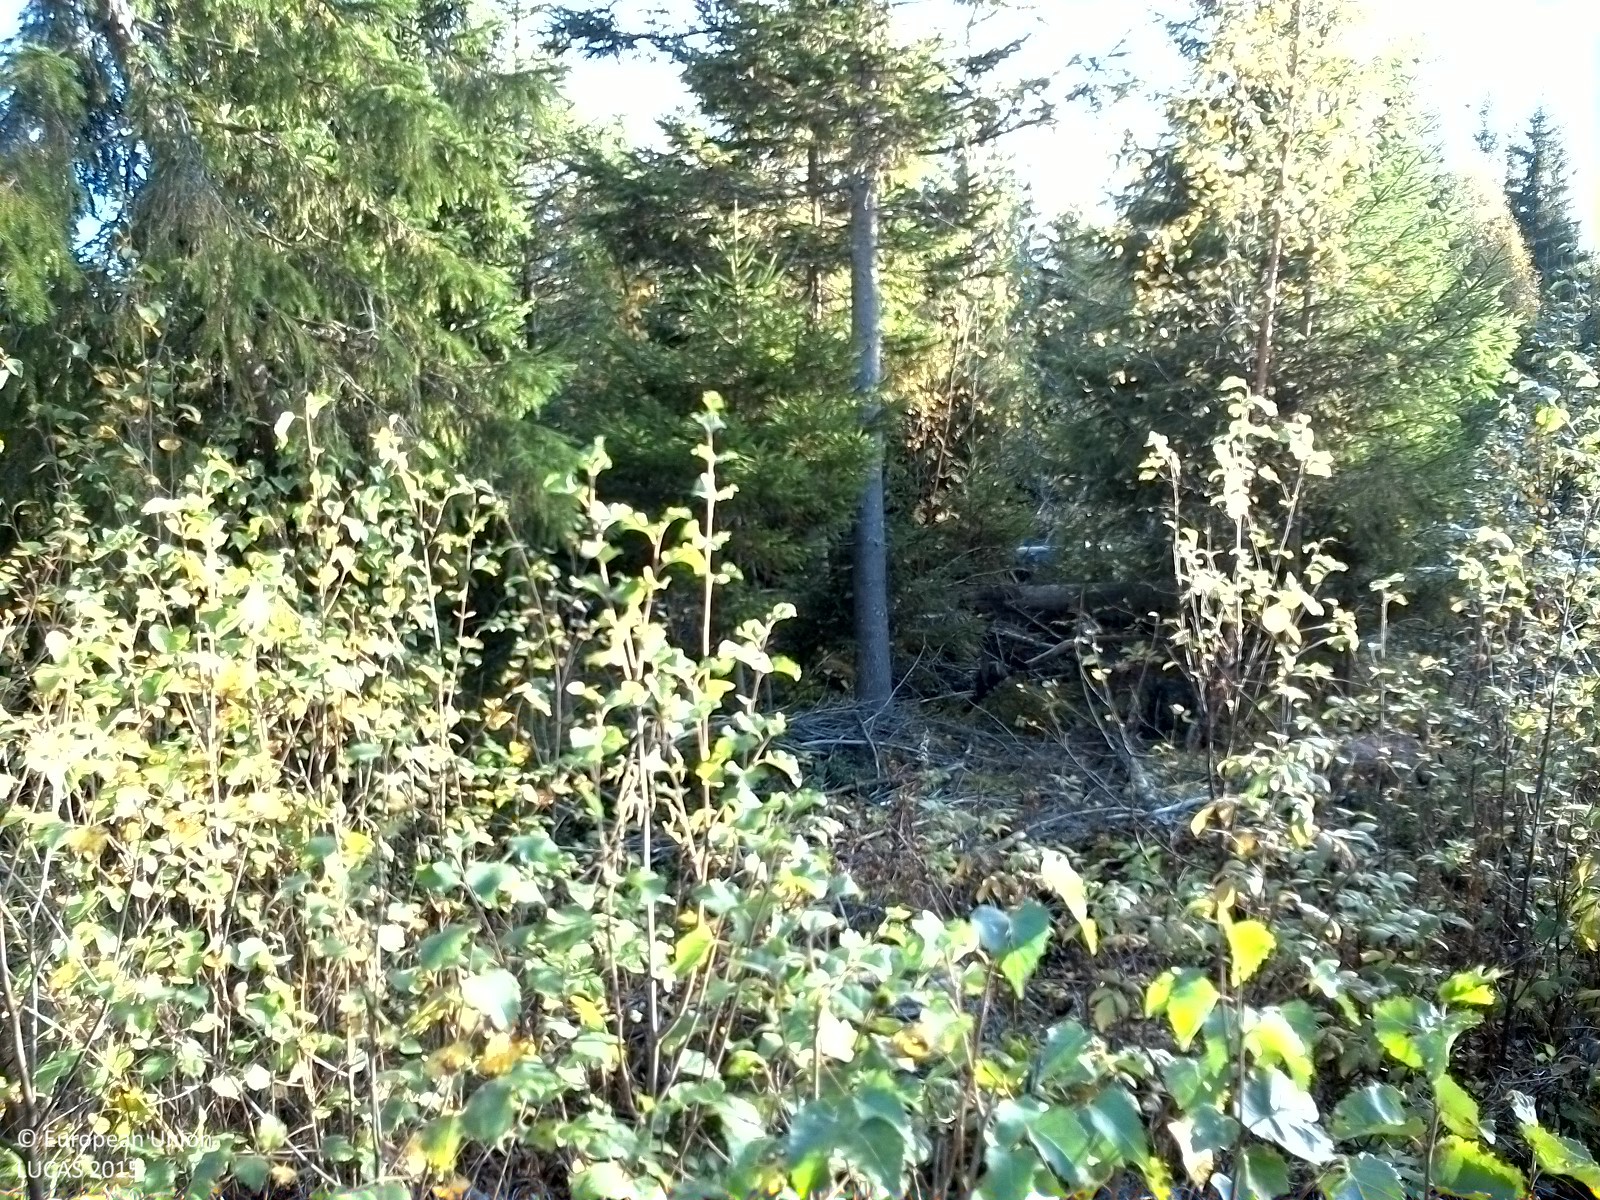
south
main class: Woodland
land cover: Spruce dominated mixed woodland
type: boreal forest
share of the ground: > 75 %
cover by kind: broadleaved forest trees 60 %, coniferous forest trees 20 %, shrubs 20 %
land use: Forestry
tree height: < 5 m
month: September
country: SE
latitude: 62.0958
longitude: 16.8194
